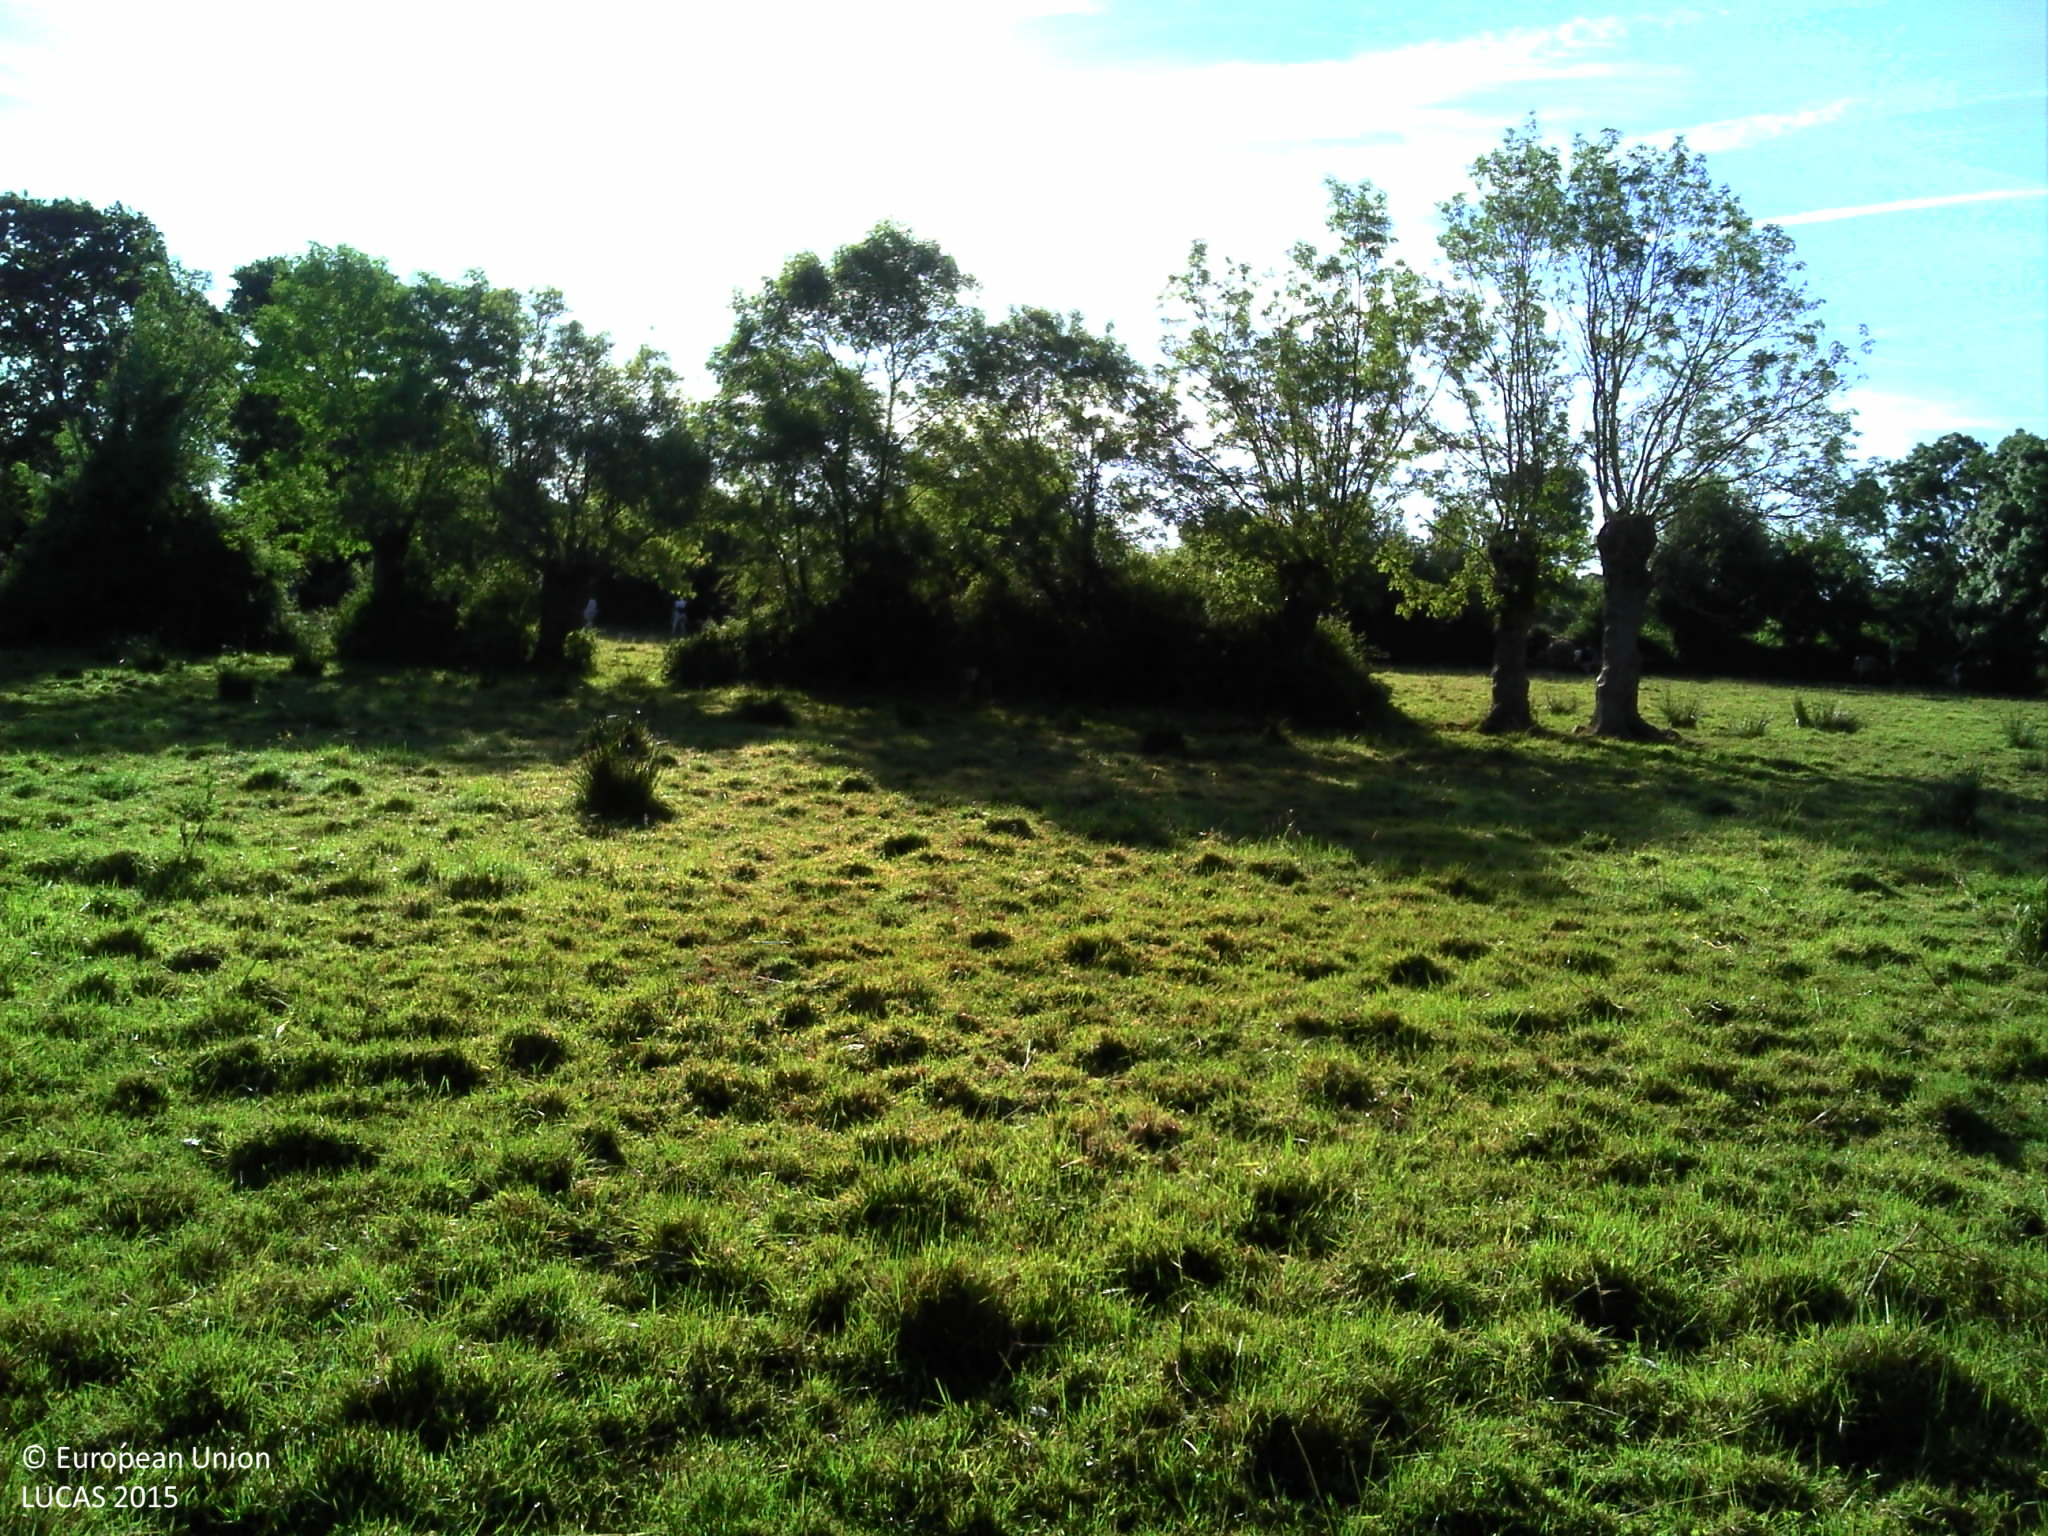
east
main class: Grassland
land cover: Grassland without tree/shrub cover
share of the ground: > 75 %
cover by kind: herbaceous plants 100 %
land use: Agriculture (excluding fallow land and kitchen gardens)
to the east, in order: Grassland without tree/shrub cover; Lines of trees; Grassland without tree/shrub cover; Fences; Broadleaved woodland; Electric lines; Ditches and canals; Grass margins; Paved roads, cycling and walking lanes; Grass margins; Ditches and canals; Managed hedges; Fences; Electric lines; Grassland without tree/shrub cover; Single bushes/trees; Grassland without tree/shrub cover
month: June
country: FR
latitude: 47.2404
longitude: -1.9769
